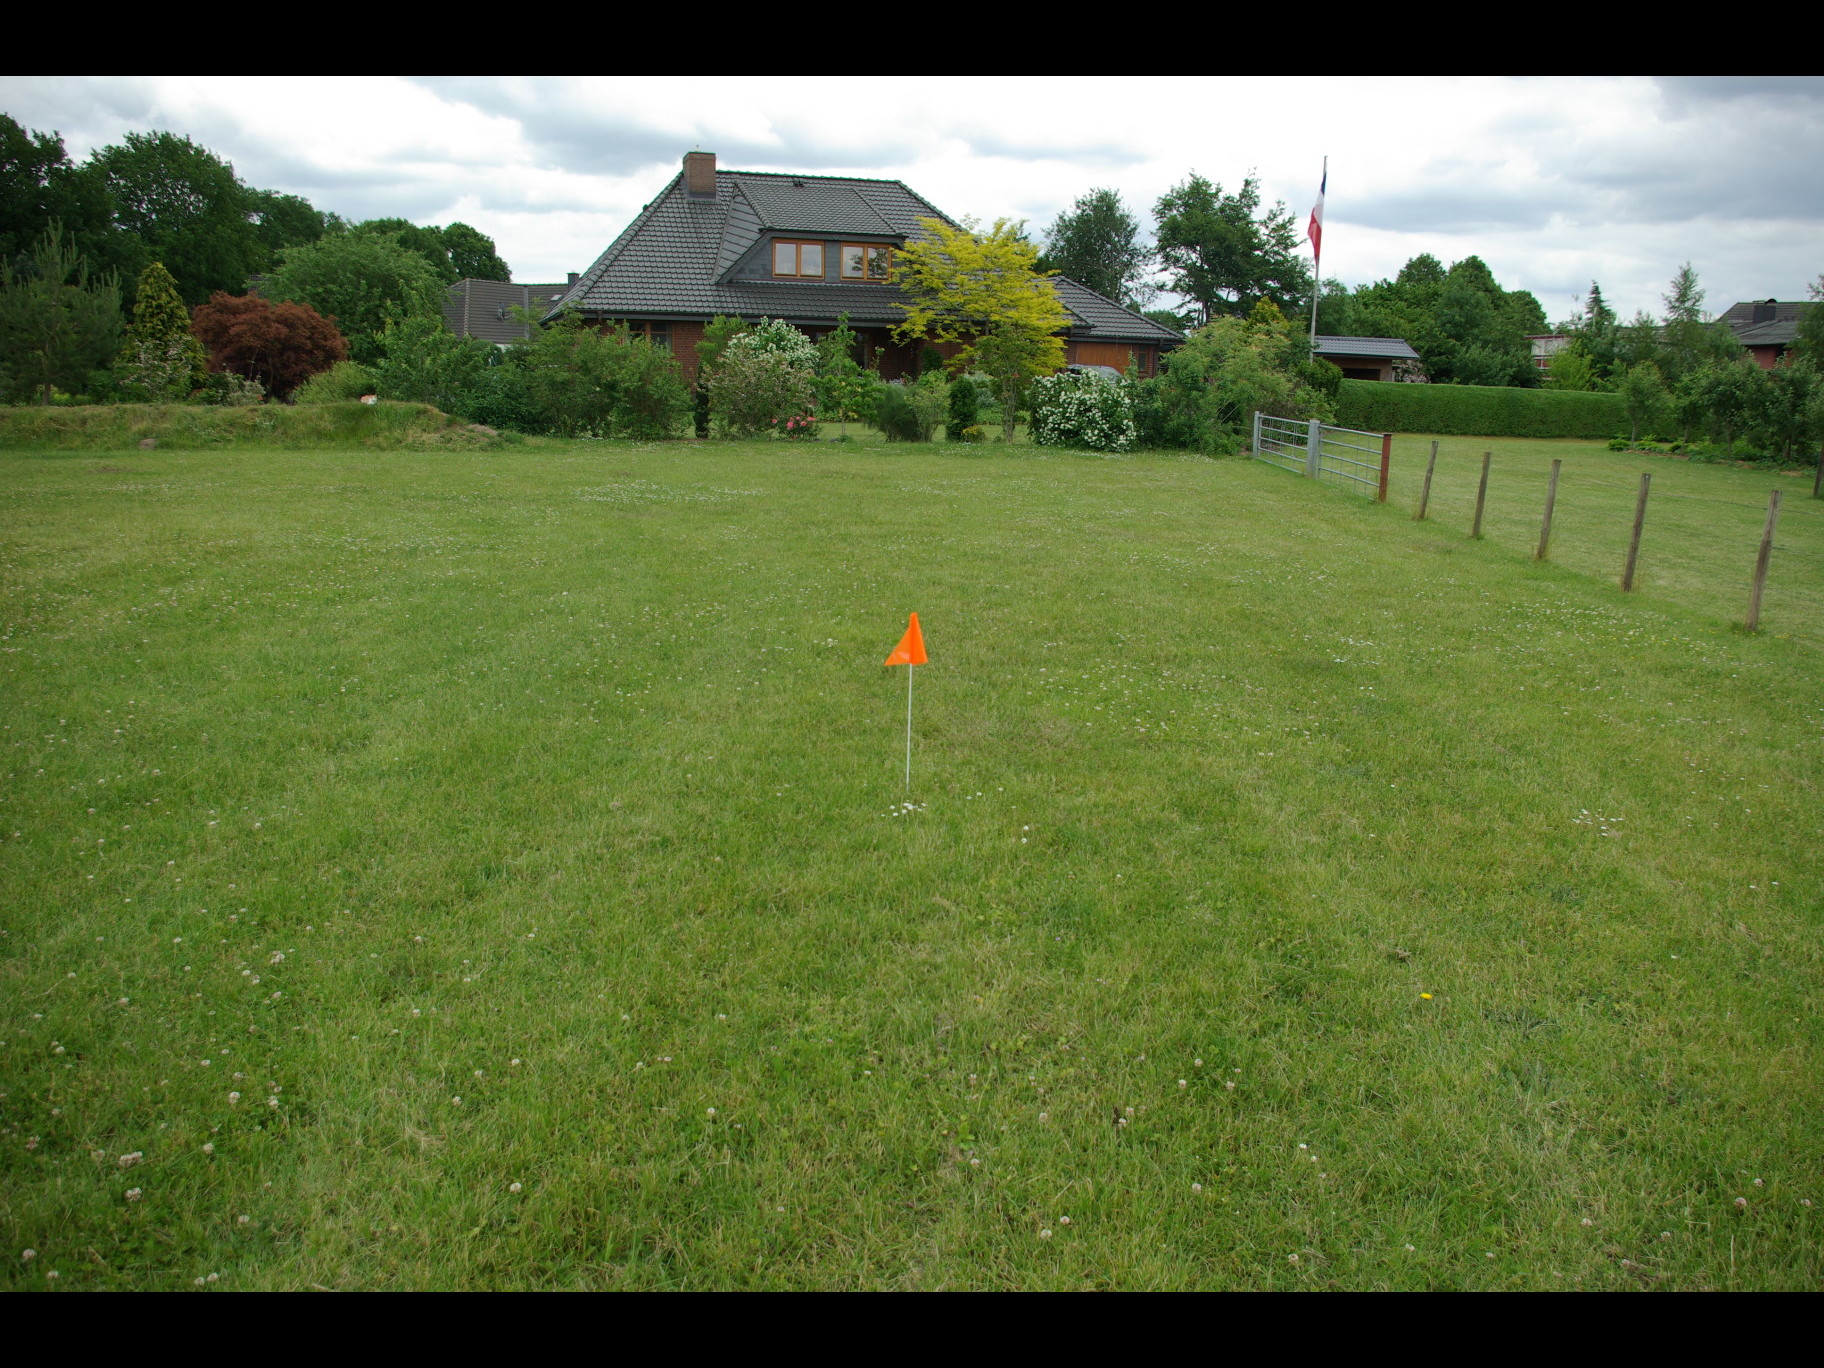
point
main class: Grassland
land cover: Grassland without tree/shrub cover
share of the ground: > 75 %
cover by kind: herbaceous plants 100 %
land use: Agriculture (excluding fallow land and kitchen gardens)
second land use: Amenities, museums, leisure
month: June
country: DE
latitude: 54.1387
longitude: 9.8929
